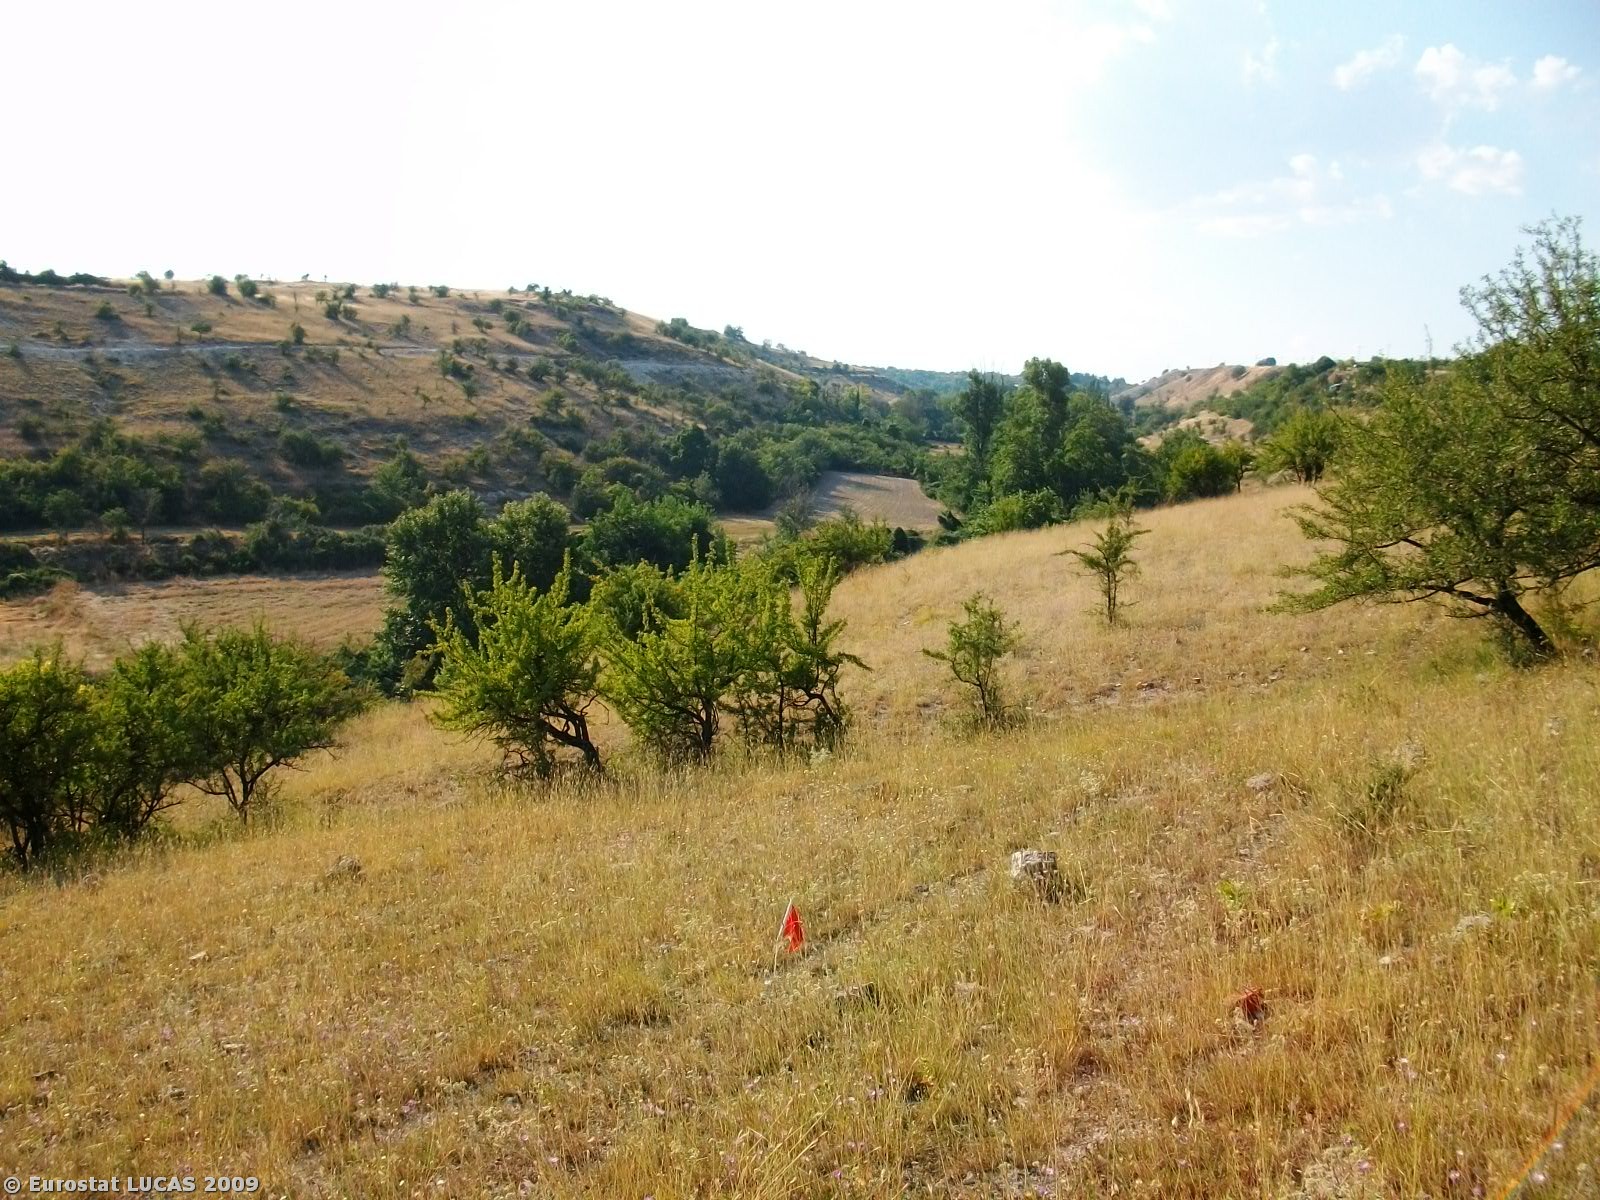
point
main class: Grassland
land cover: Grassland with sparse tree/shrub cover
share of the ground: > 75 %
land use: Unused
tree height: > 5 m
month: July
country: GR
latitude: 40.2431
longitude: 21.8289
